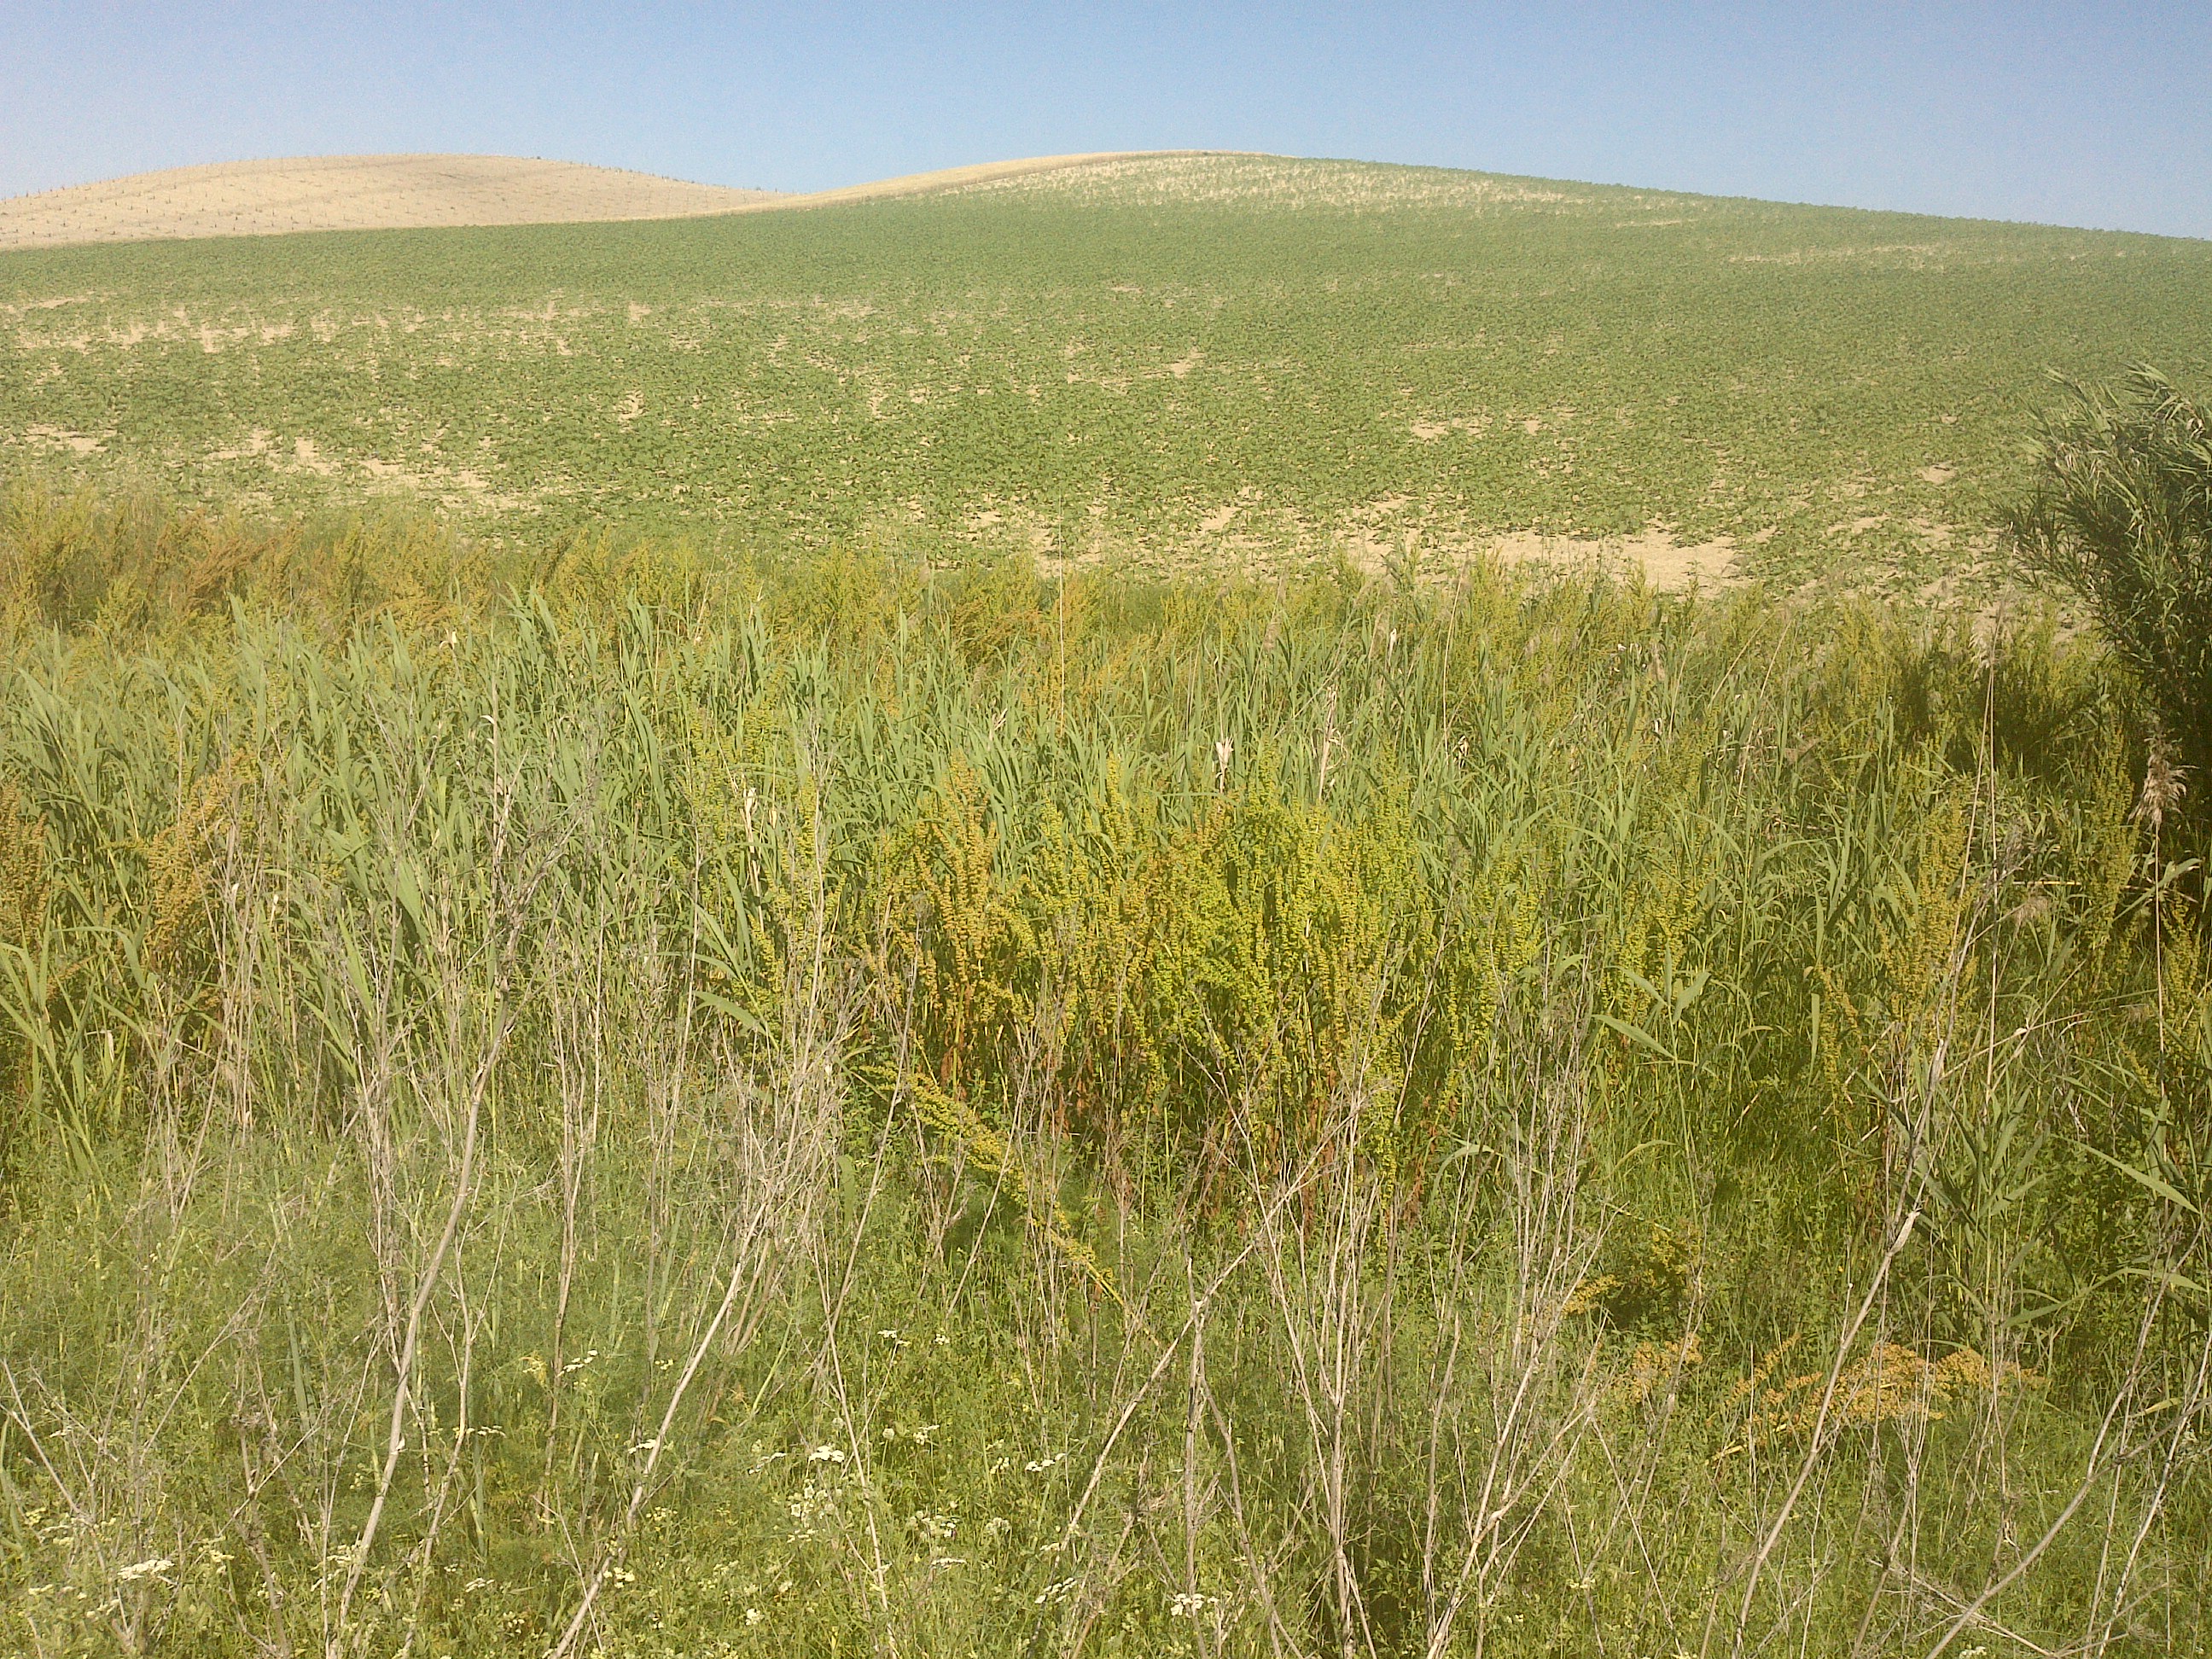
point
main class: Shrubland
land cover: Shrubland with sparse tree cover
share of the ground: 25 - 50 %
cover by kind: shrubs 65 %, herbaceous plants 30 %, broadleaved forest trees 5 %
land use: Semi-natural and natural areas not in use
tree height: < 5 m
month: May
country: ES
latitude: 37.7837
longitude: -4.6471
